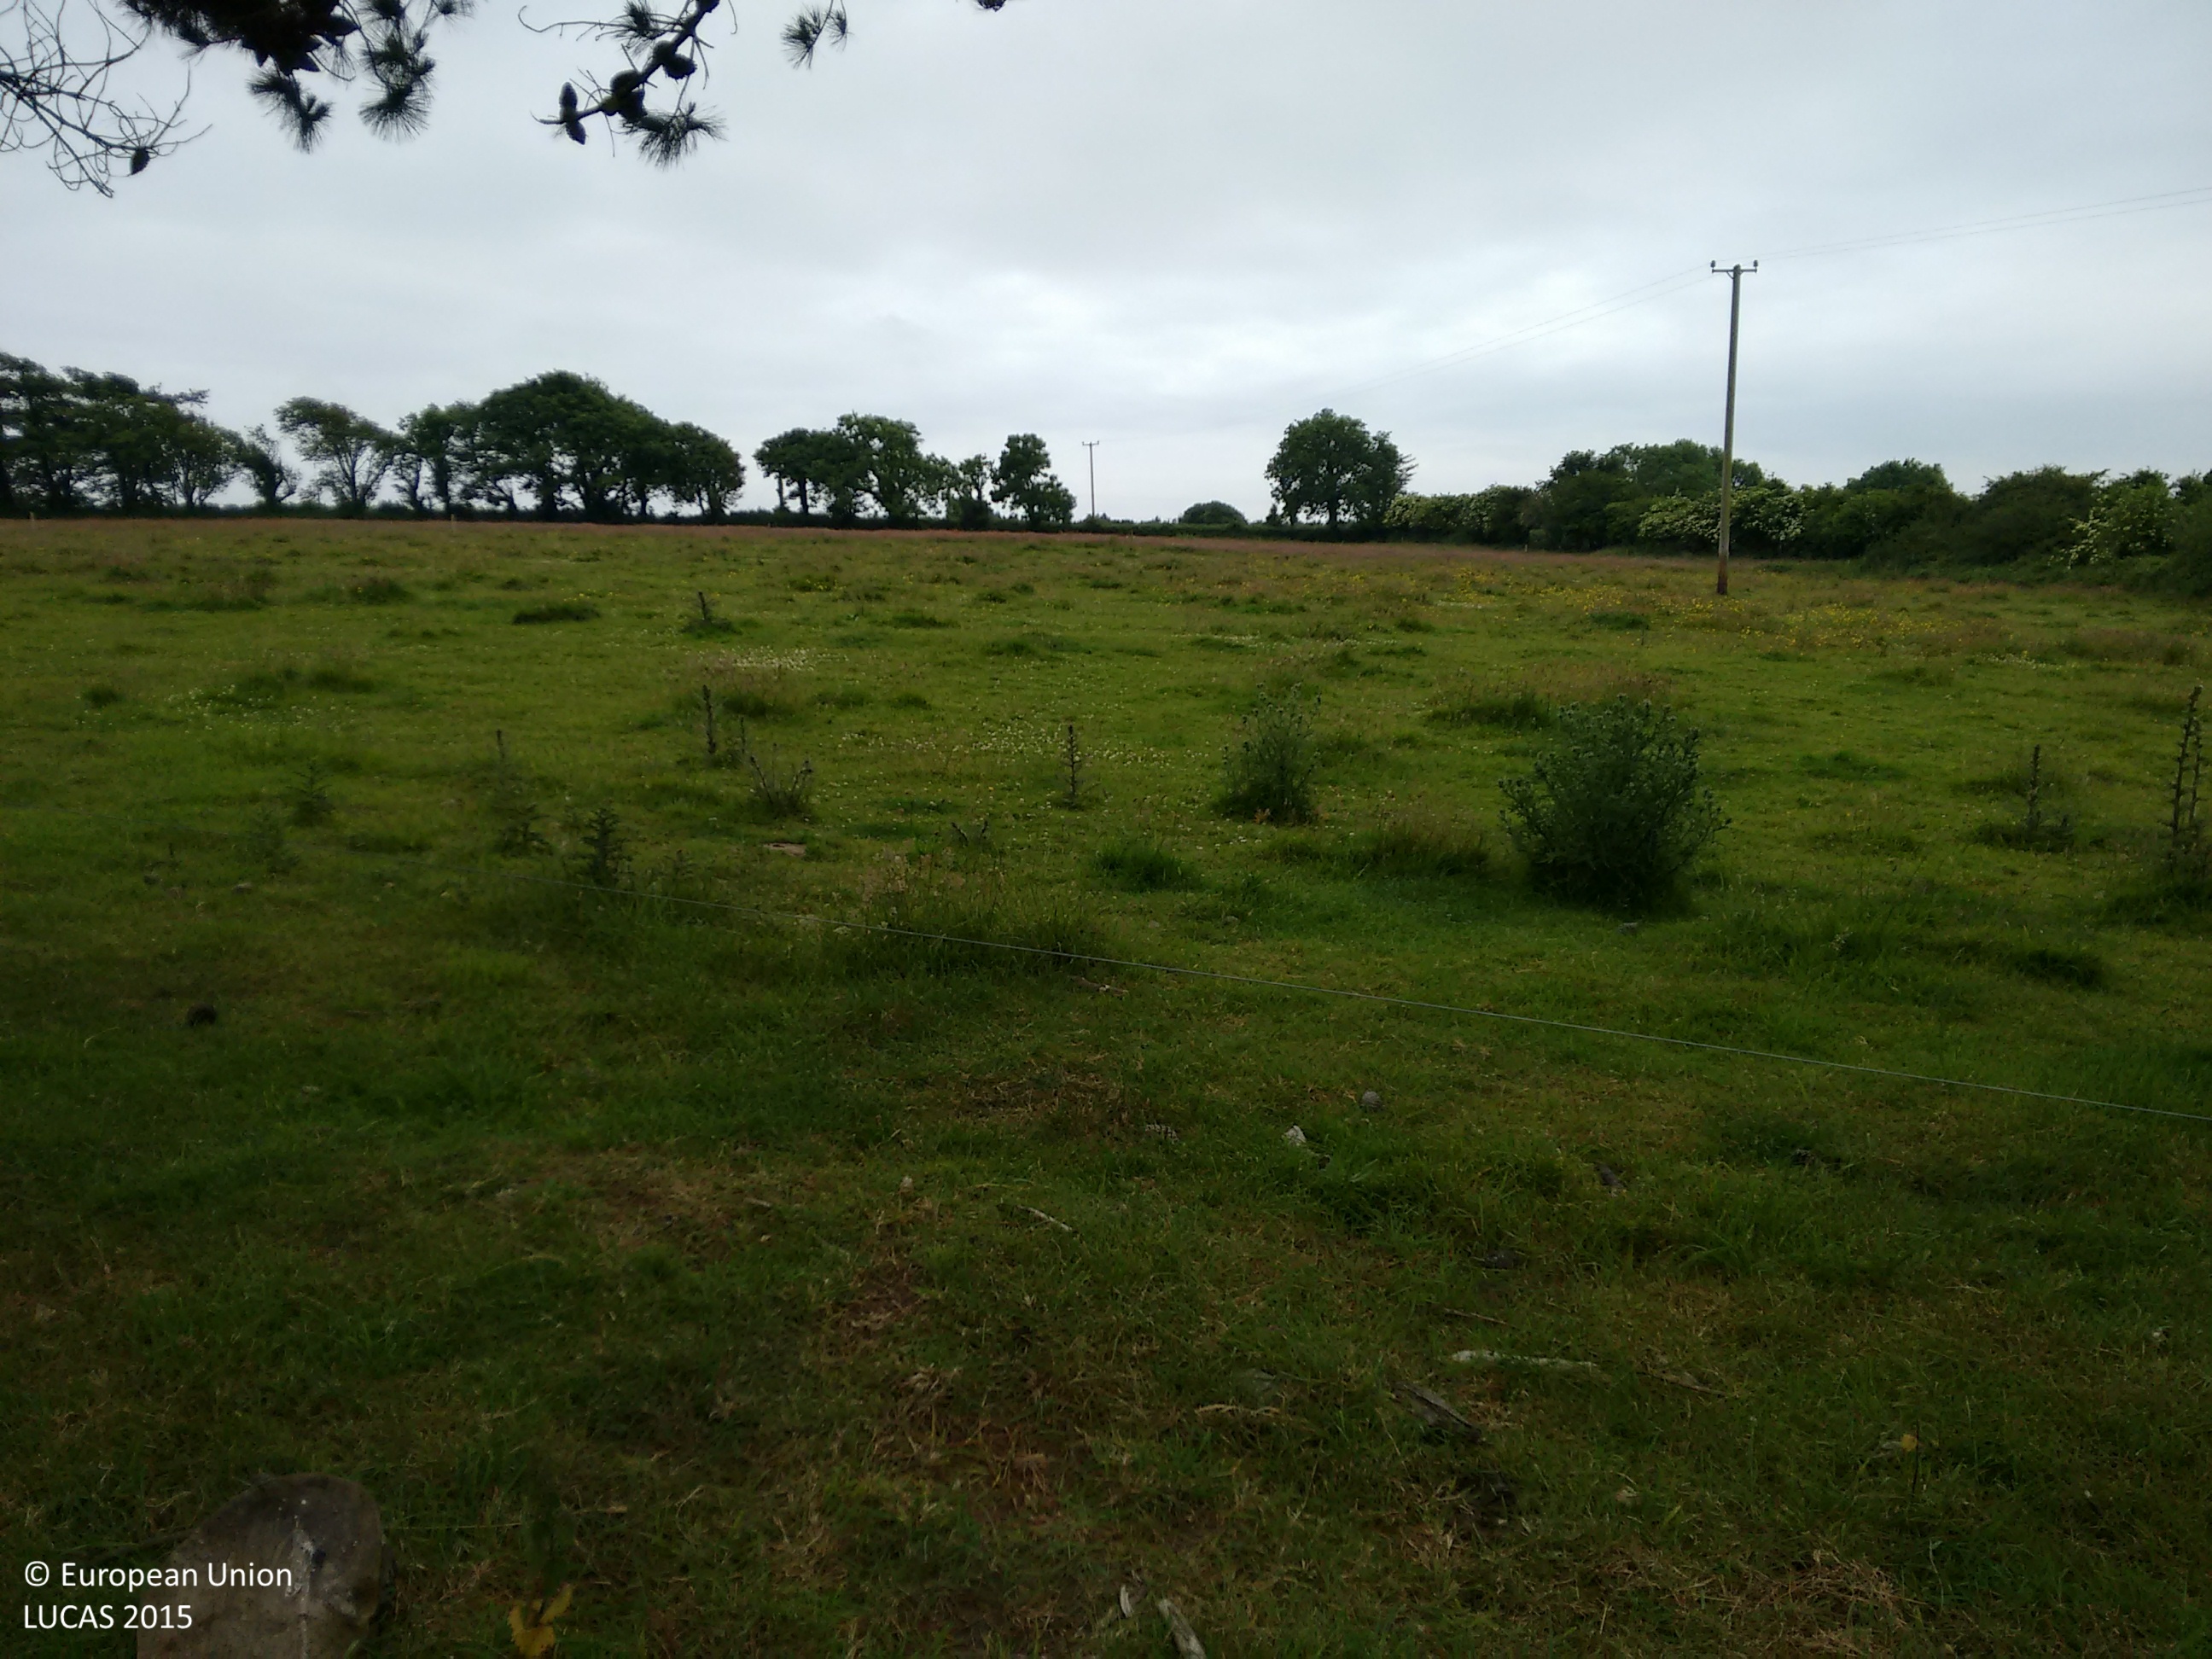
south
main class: Grassland
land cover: Grassland with sparse tree/shrub cover
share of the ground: > 75 %
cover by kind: herbaceous plants 95 %, coniferous forest trees 5 %
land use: Agriculture (excluding fallow land and kitchen gardens)
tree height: > 5 m
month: June
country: IE
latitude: 52.1904
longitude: -7.1001
